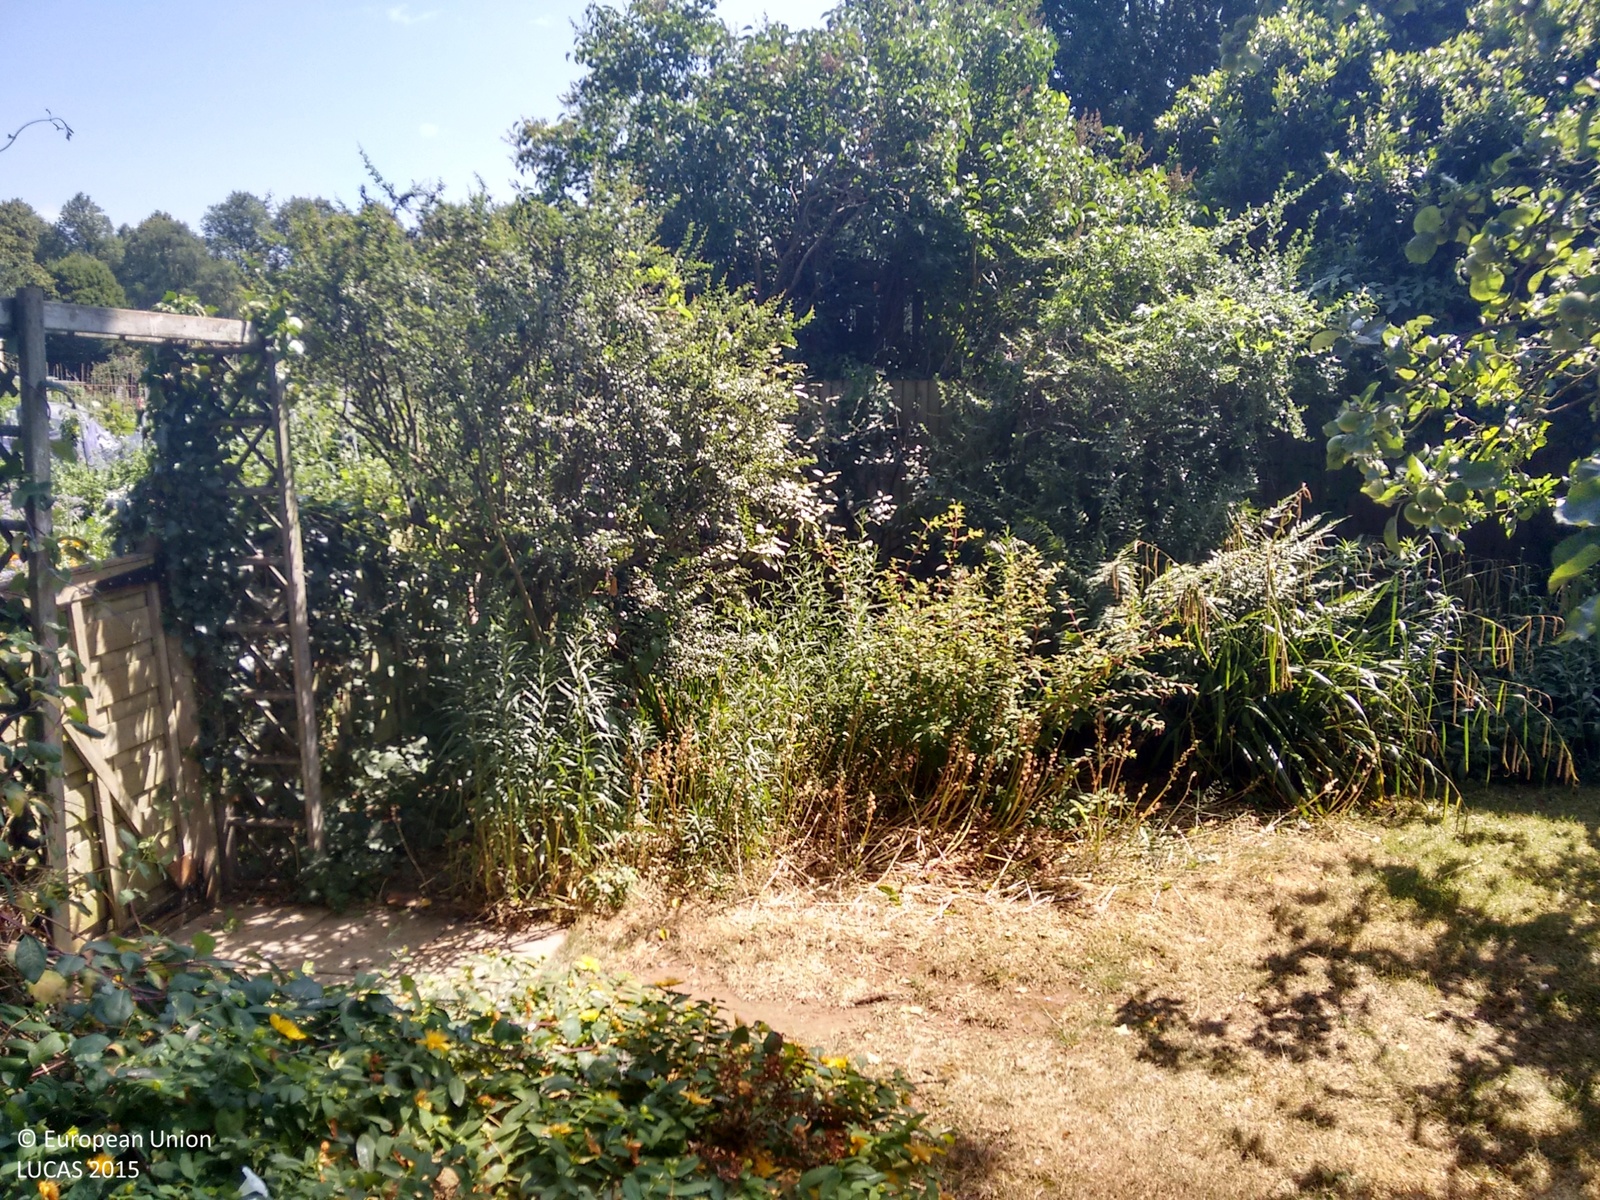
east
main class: Woodland
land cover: Broadleaved woodland
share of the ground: > 75 %
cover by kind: broadleaved forest trees 100 %
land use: Residential
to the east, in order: Broadleaved woodland; Artificial constructions in urban areas
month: July
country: GB
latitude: 51.1750
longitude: -0.6101
